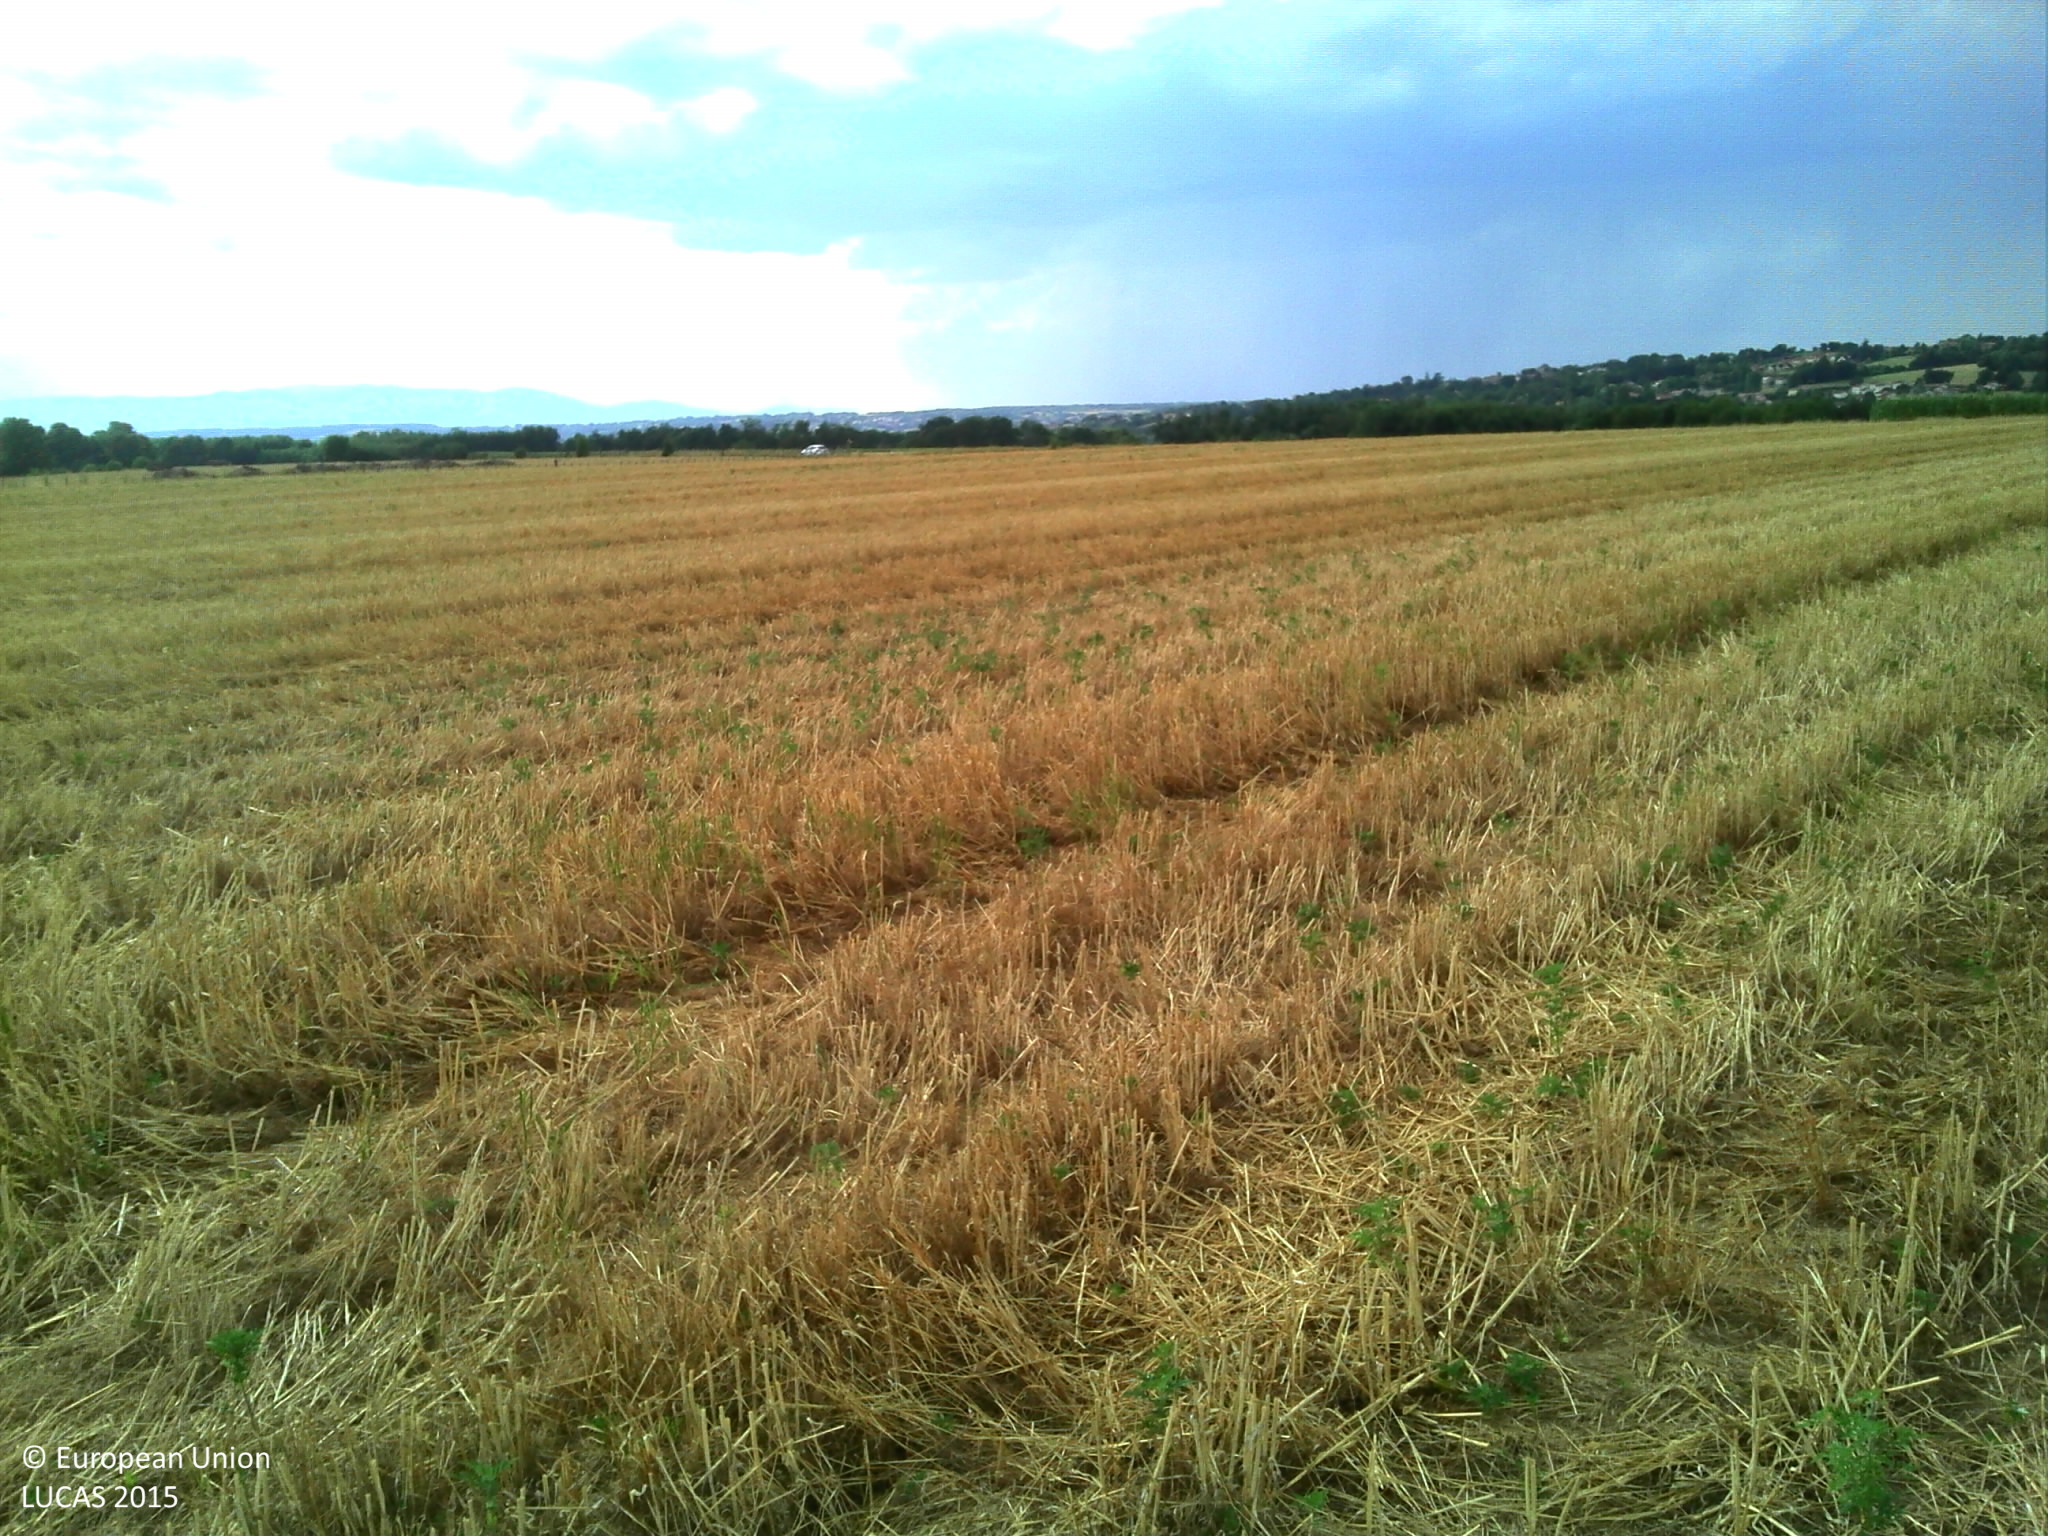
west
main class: Cropland
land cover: Common wheat
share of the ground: > 75 %
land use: Agriculture (excluding fallow land and kitchen gardens)
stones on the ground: < 10 %
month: July
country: FR
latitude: 45.3709
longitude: 5.0633
